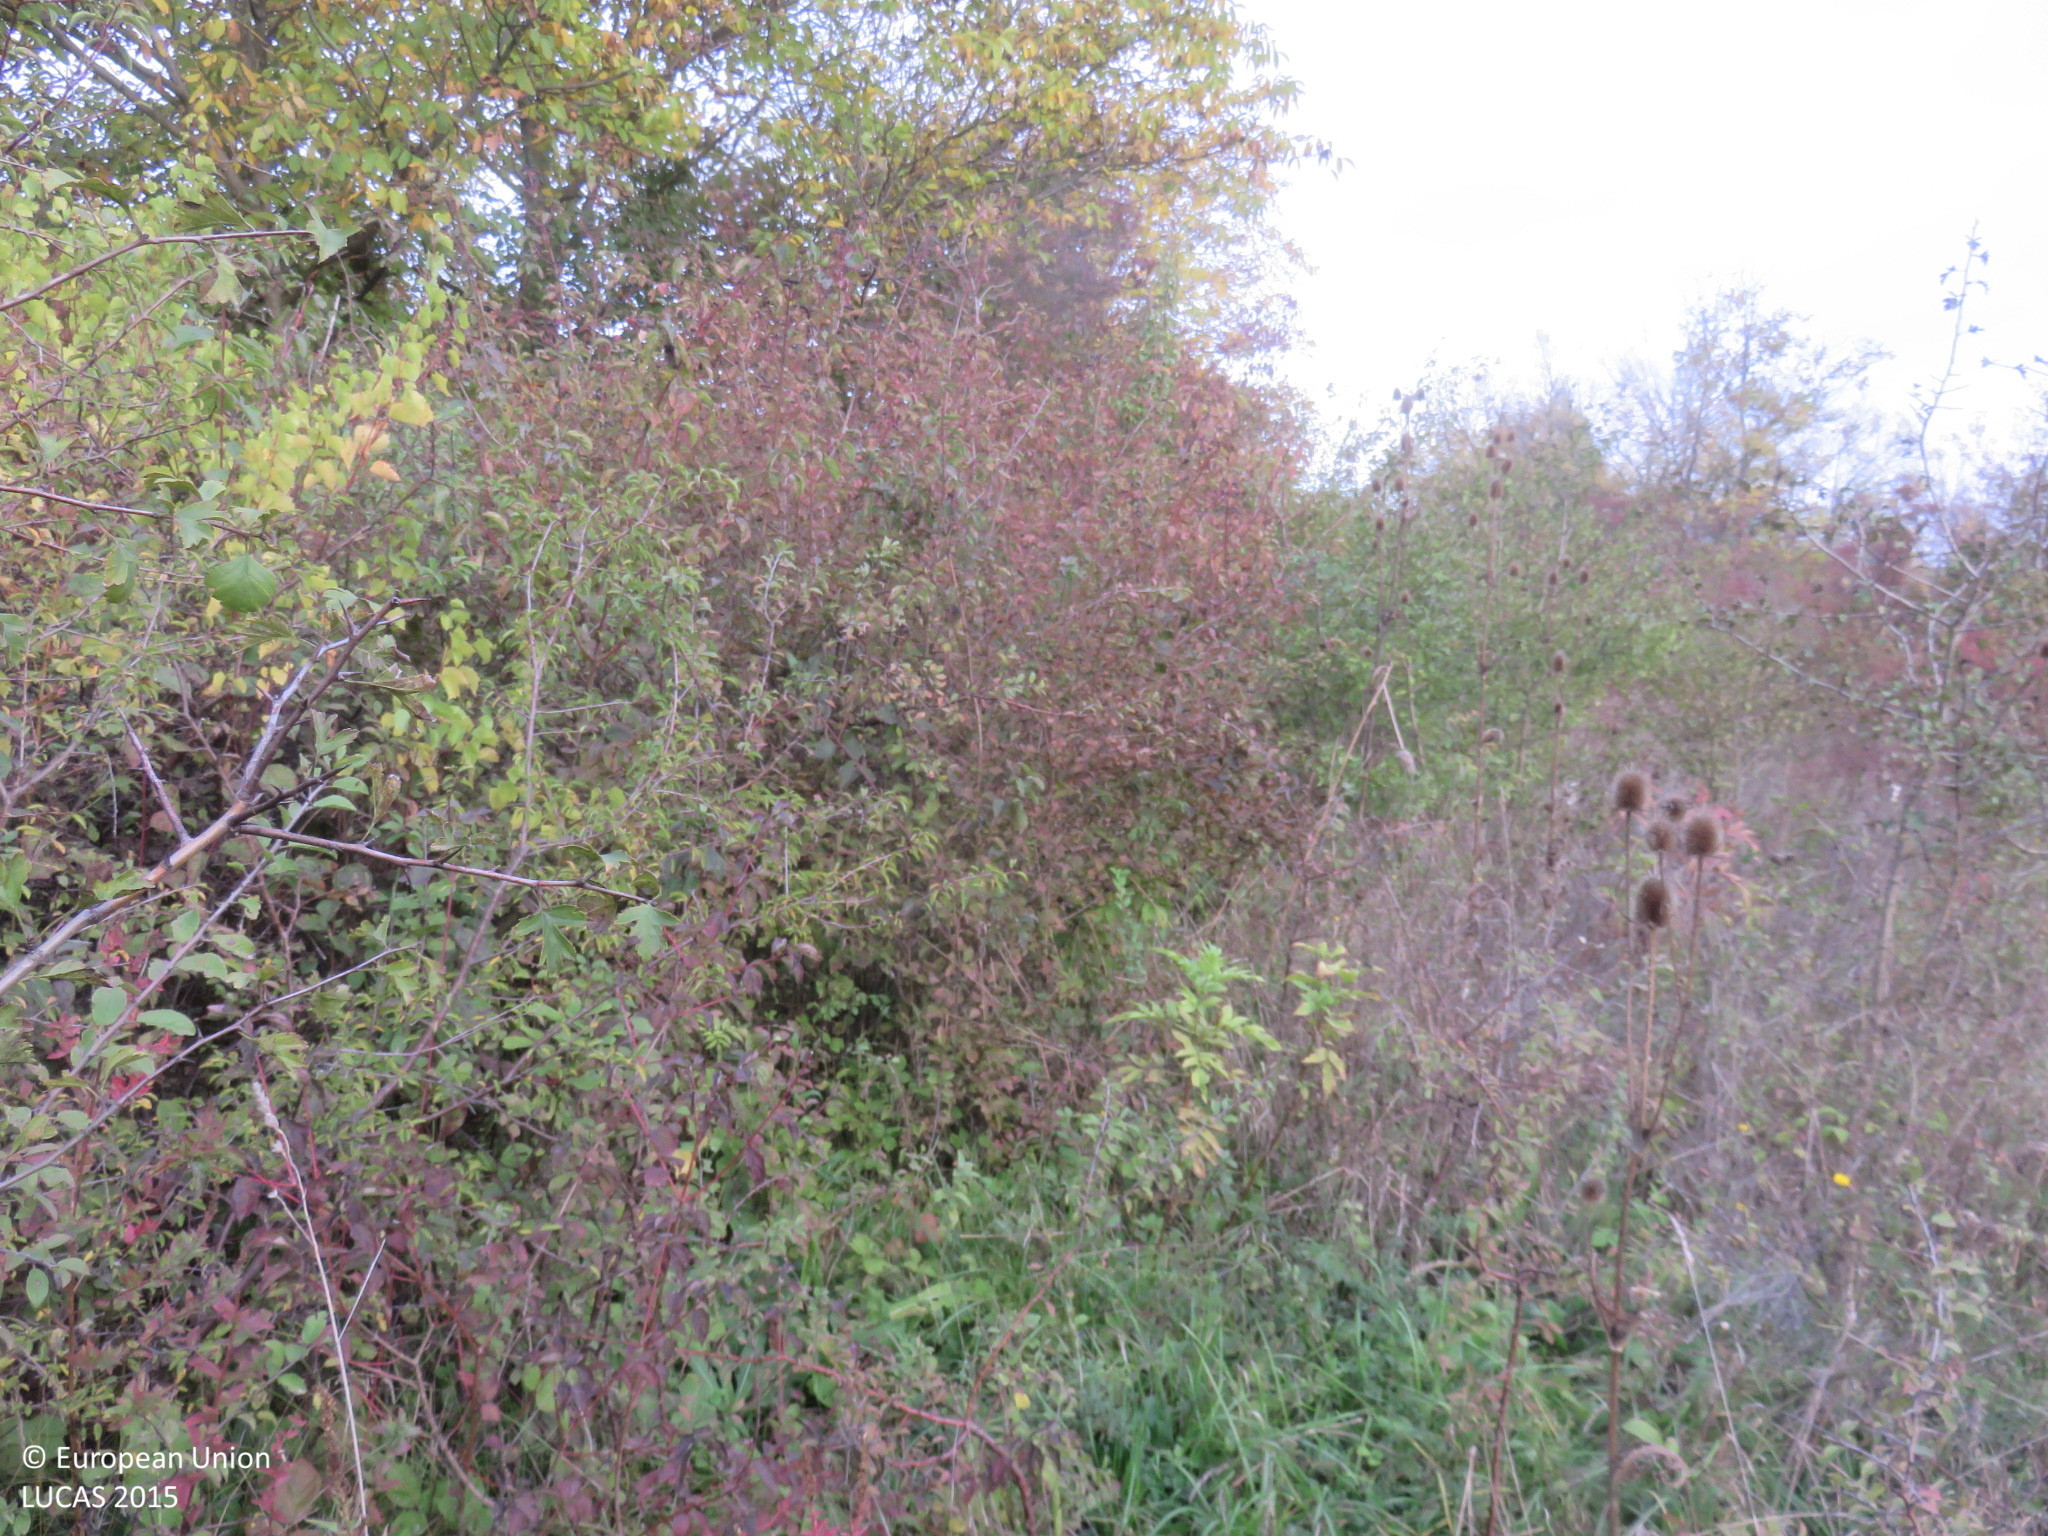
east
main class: Shrubland
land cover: Shrubland with sparse tree cover
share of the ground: > 75 %
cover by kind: shrubs 95 %, broadleaved forest trees 5 %
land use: Abandoned areas
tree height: < 5 m
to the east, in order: Shrubland with sparse tree cover; Nuts trees; Shrubland with sparse tree cover; Nuts trees; Shrubland with sparse tree cover; Broadleaved woodland; Shrubland with sparse tree cover
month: October
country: BG
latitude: 43.1235
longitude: 25.2521
